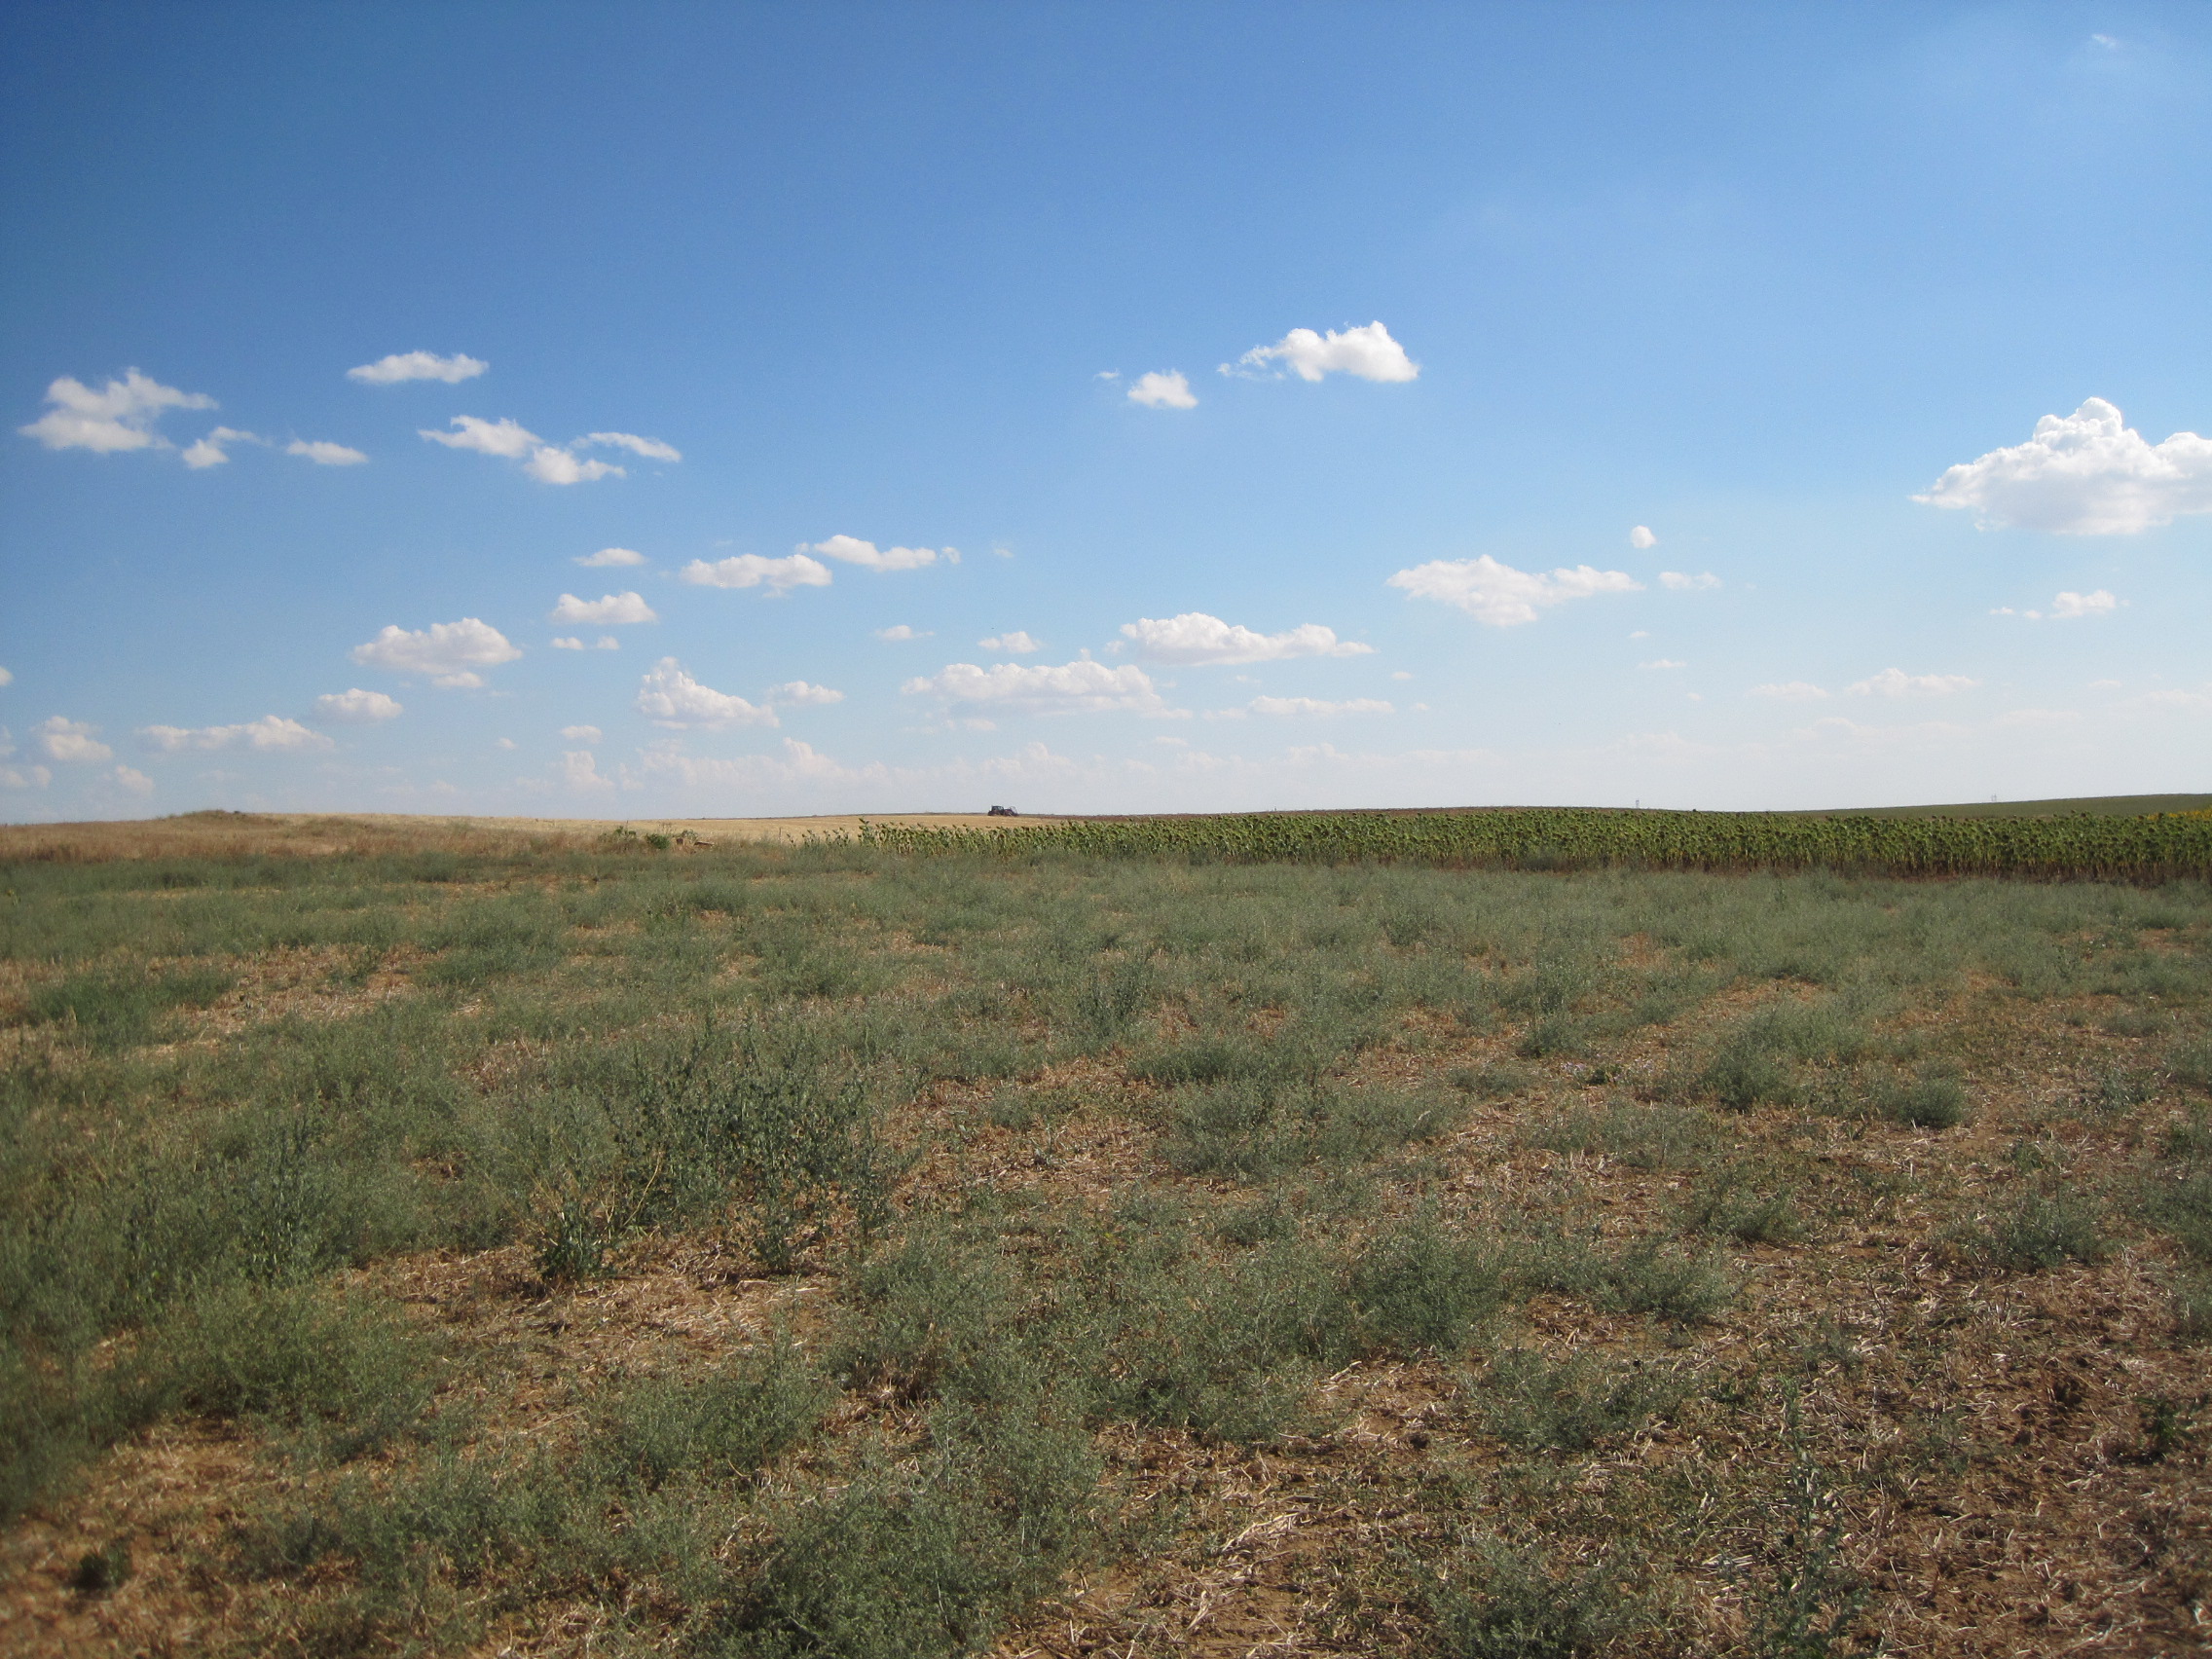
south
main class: Cropland
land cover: Dry pulses
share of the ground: < 10 %
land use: Agriculture (excluding fallow land and kitchen gardens)
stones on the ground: < 10 %
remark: Harvested field
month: July
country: ES
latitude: 41.8800
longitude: -5.2283
